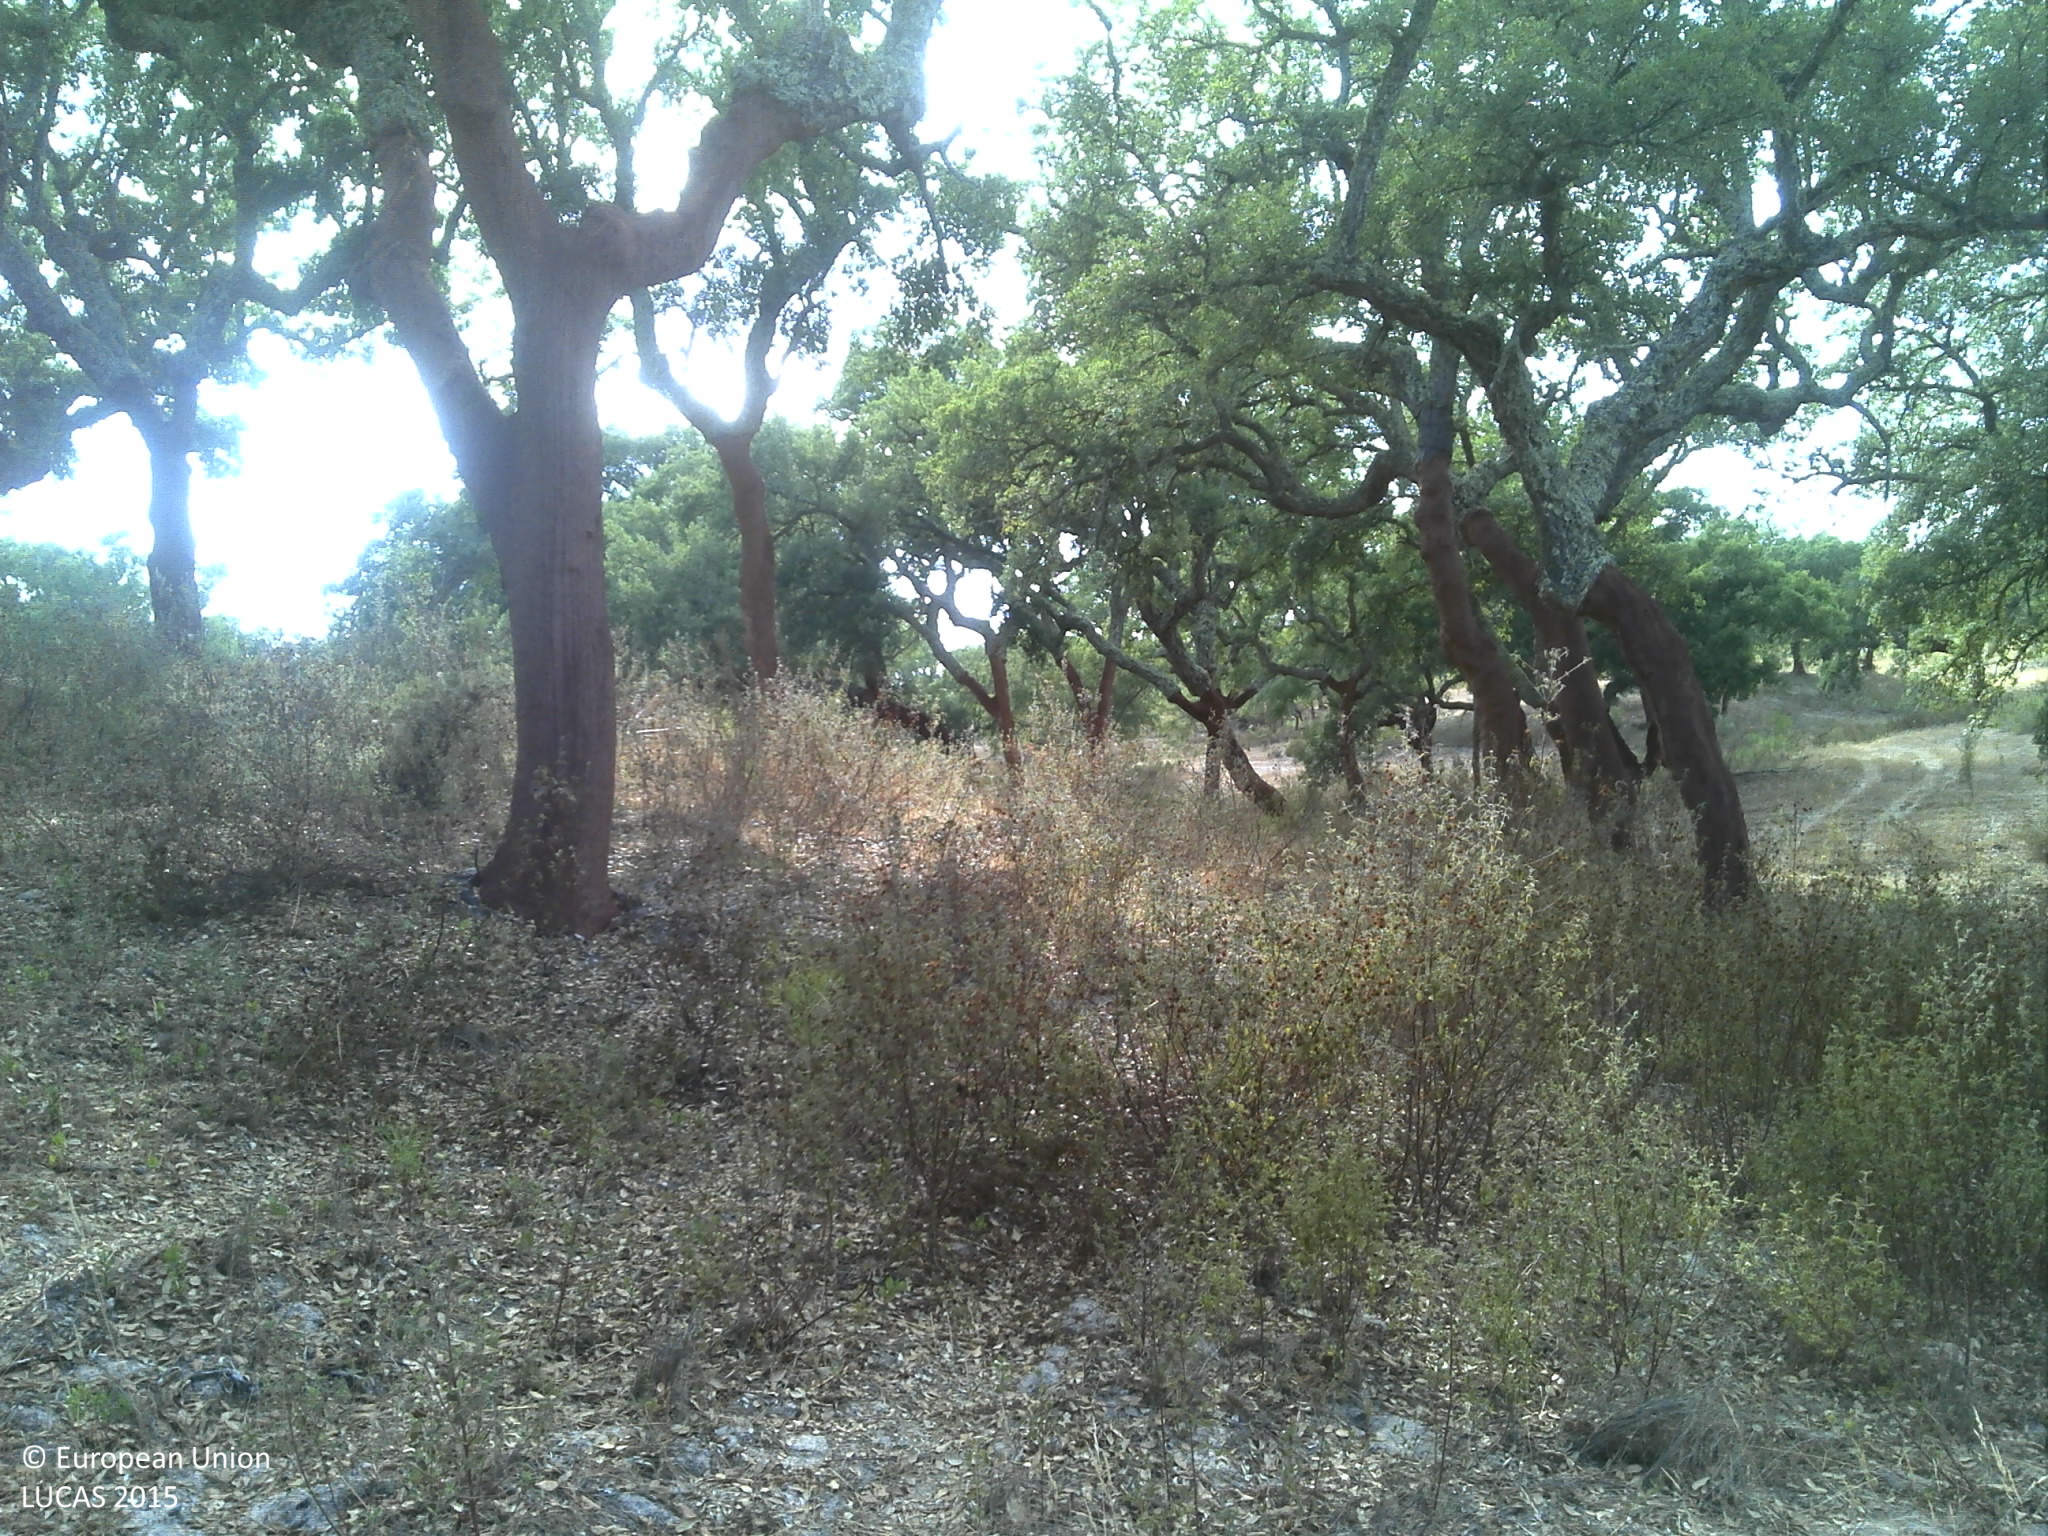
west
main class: Woodland
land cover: Broadleaved woodland
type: broadleaved evergreen forest
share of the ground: 50 - 75 %
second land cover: Grassland without tree/shrub cover
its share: 25 - 50 %
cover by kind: broadleaved forest trees 50 %, herbaceous plants 25 %, unconsolidated bare surface 25 %
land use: Forestry
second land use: Agriculture (excluding fallow land and kitchen gardens)
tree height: > 5 m
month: July
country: PT
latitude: 38.9019
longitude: -8.1908
